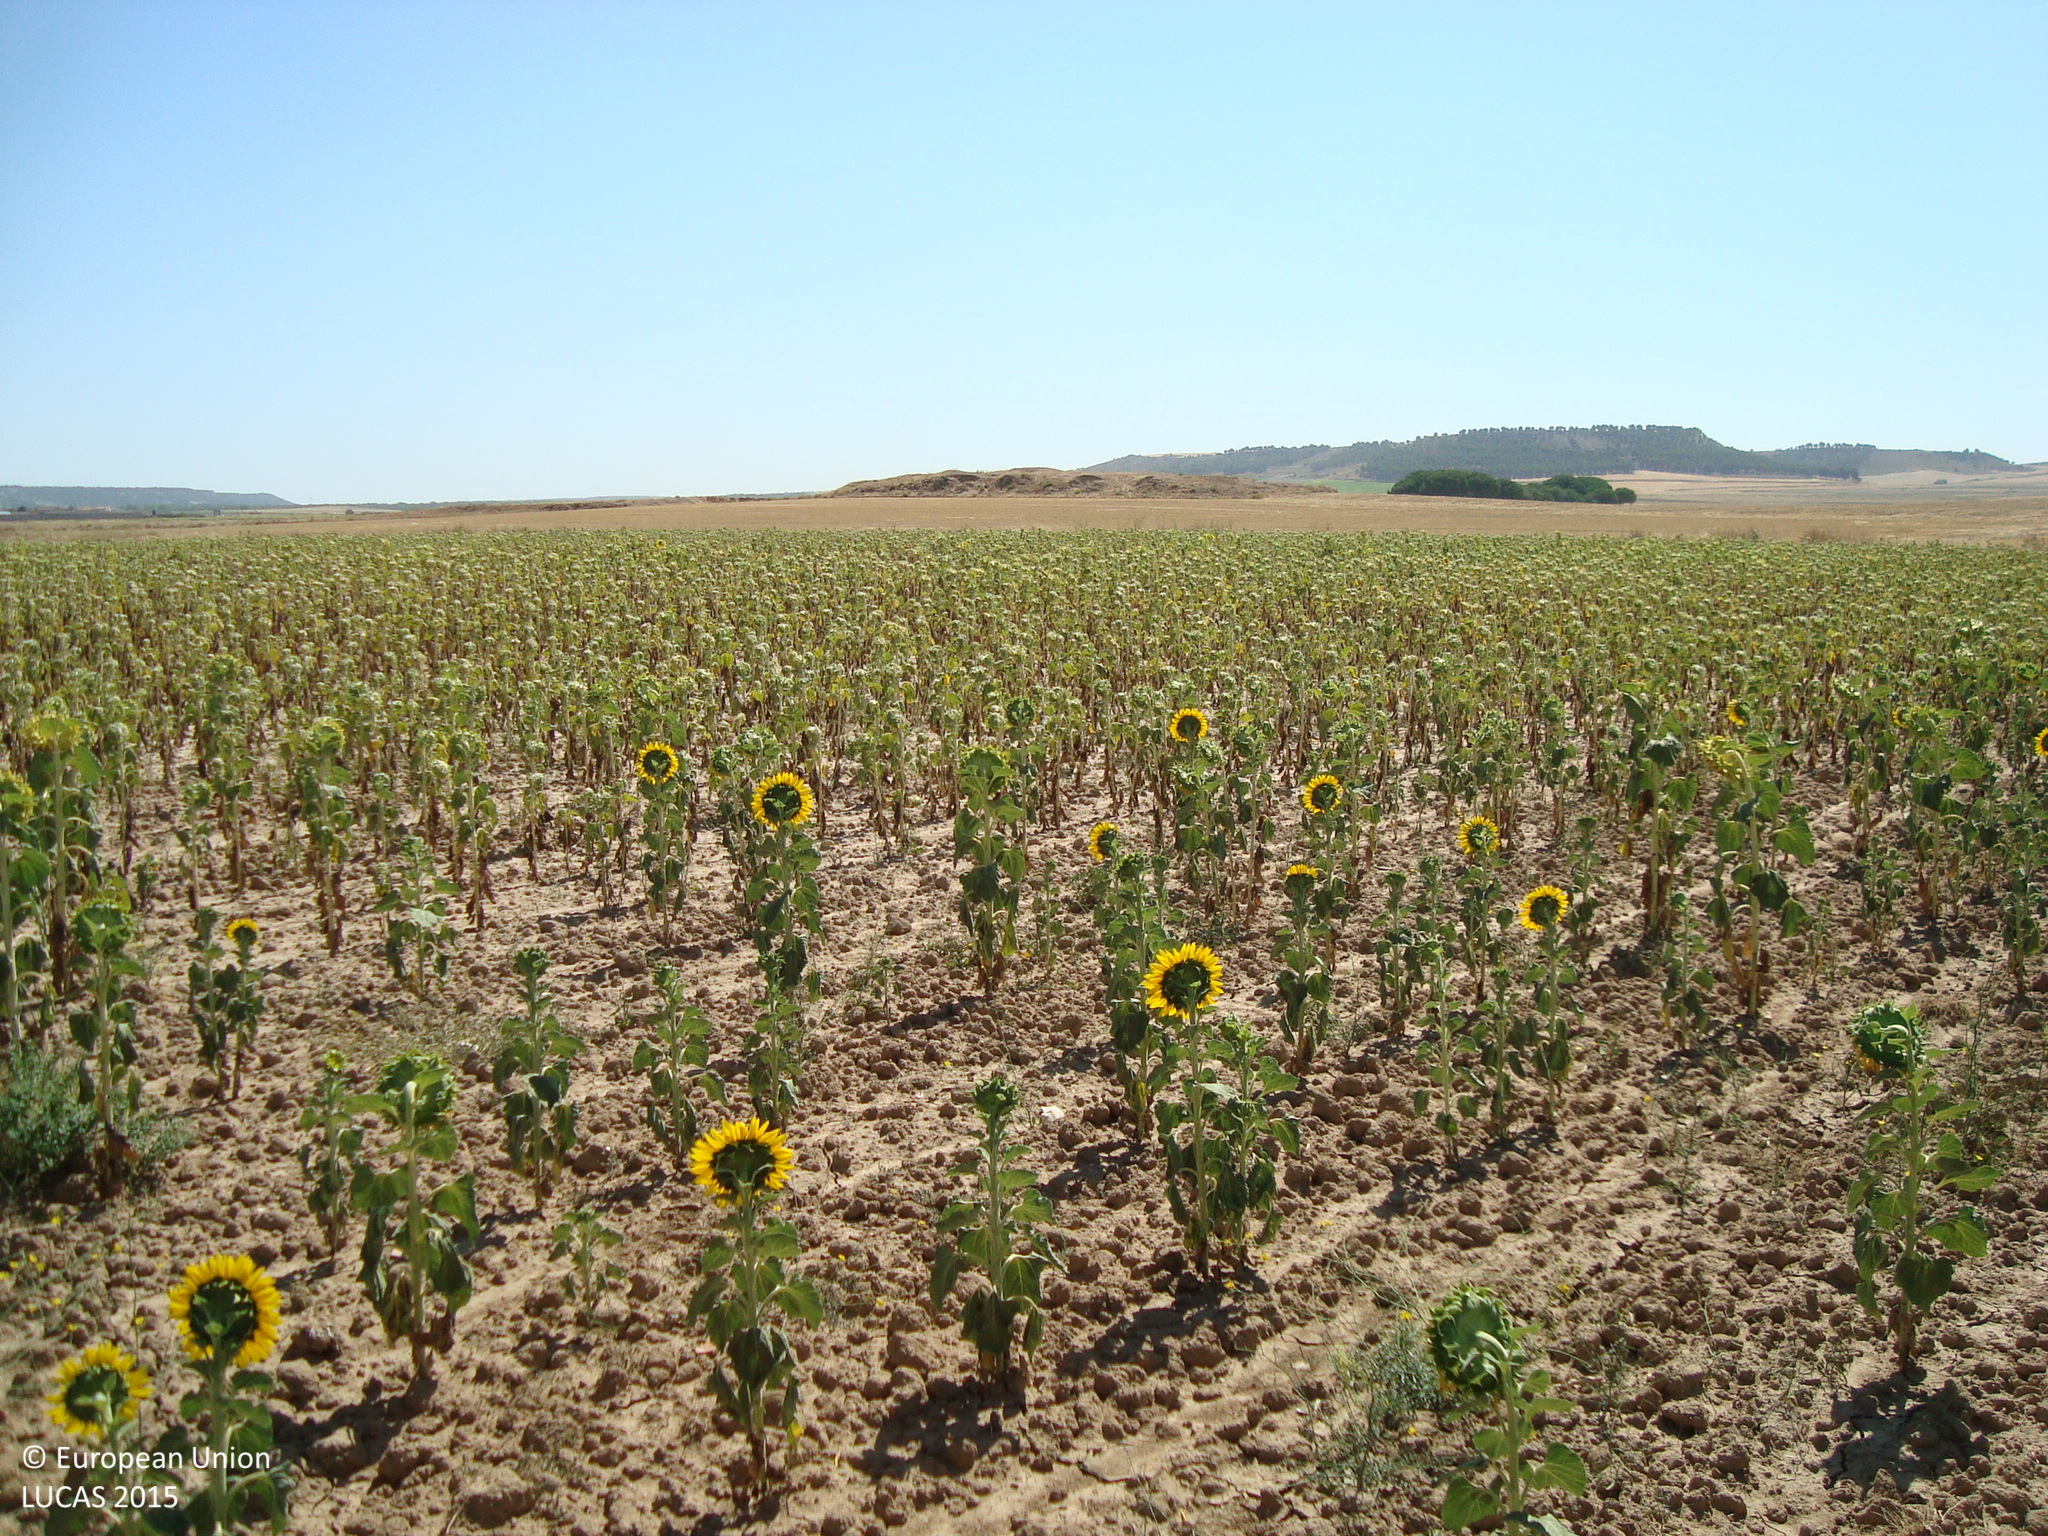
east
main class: Cropland
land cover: Sunflower
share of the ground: < 10 %
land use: Agriculture (excluding fallow land and kitchen gardens)
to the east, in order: Sunflower; Tracks; Common wheat
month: August
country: ES
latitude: 41.4562
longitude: -4.6343
